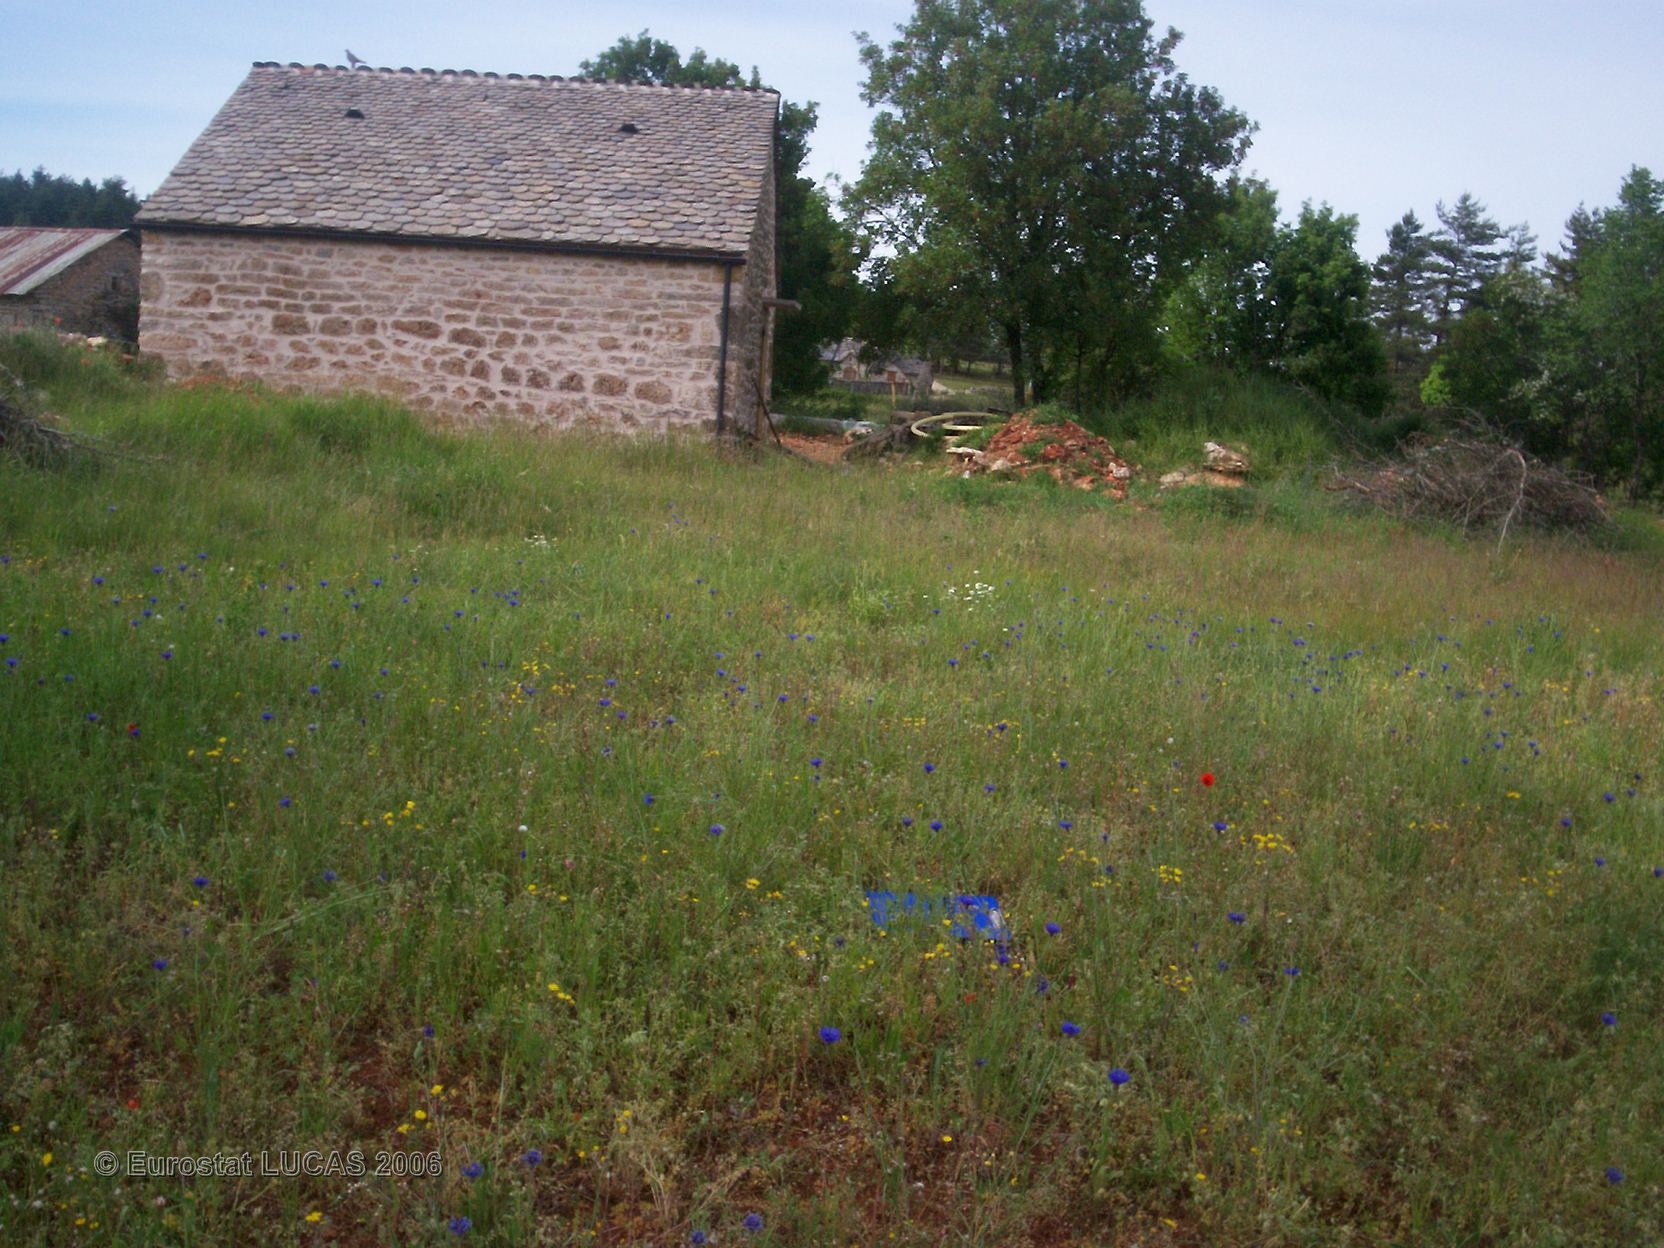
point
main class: Grassland
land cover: Grassland without tree/shrub cover
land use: Agriculture (excluding fallow land and kitchen gardens)
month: June
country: FR
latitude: 44.4680
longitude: 3.4311
